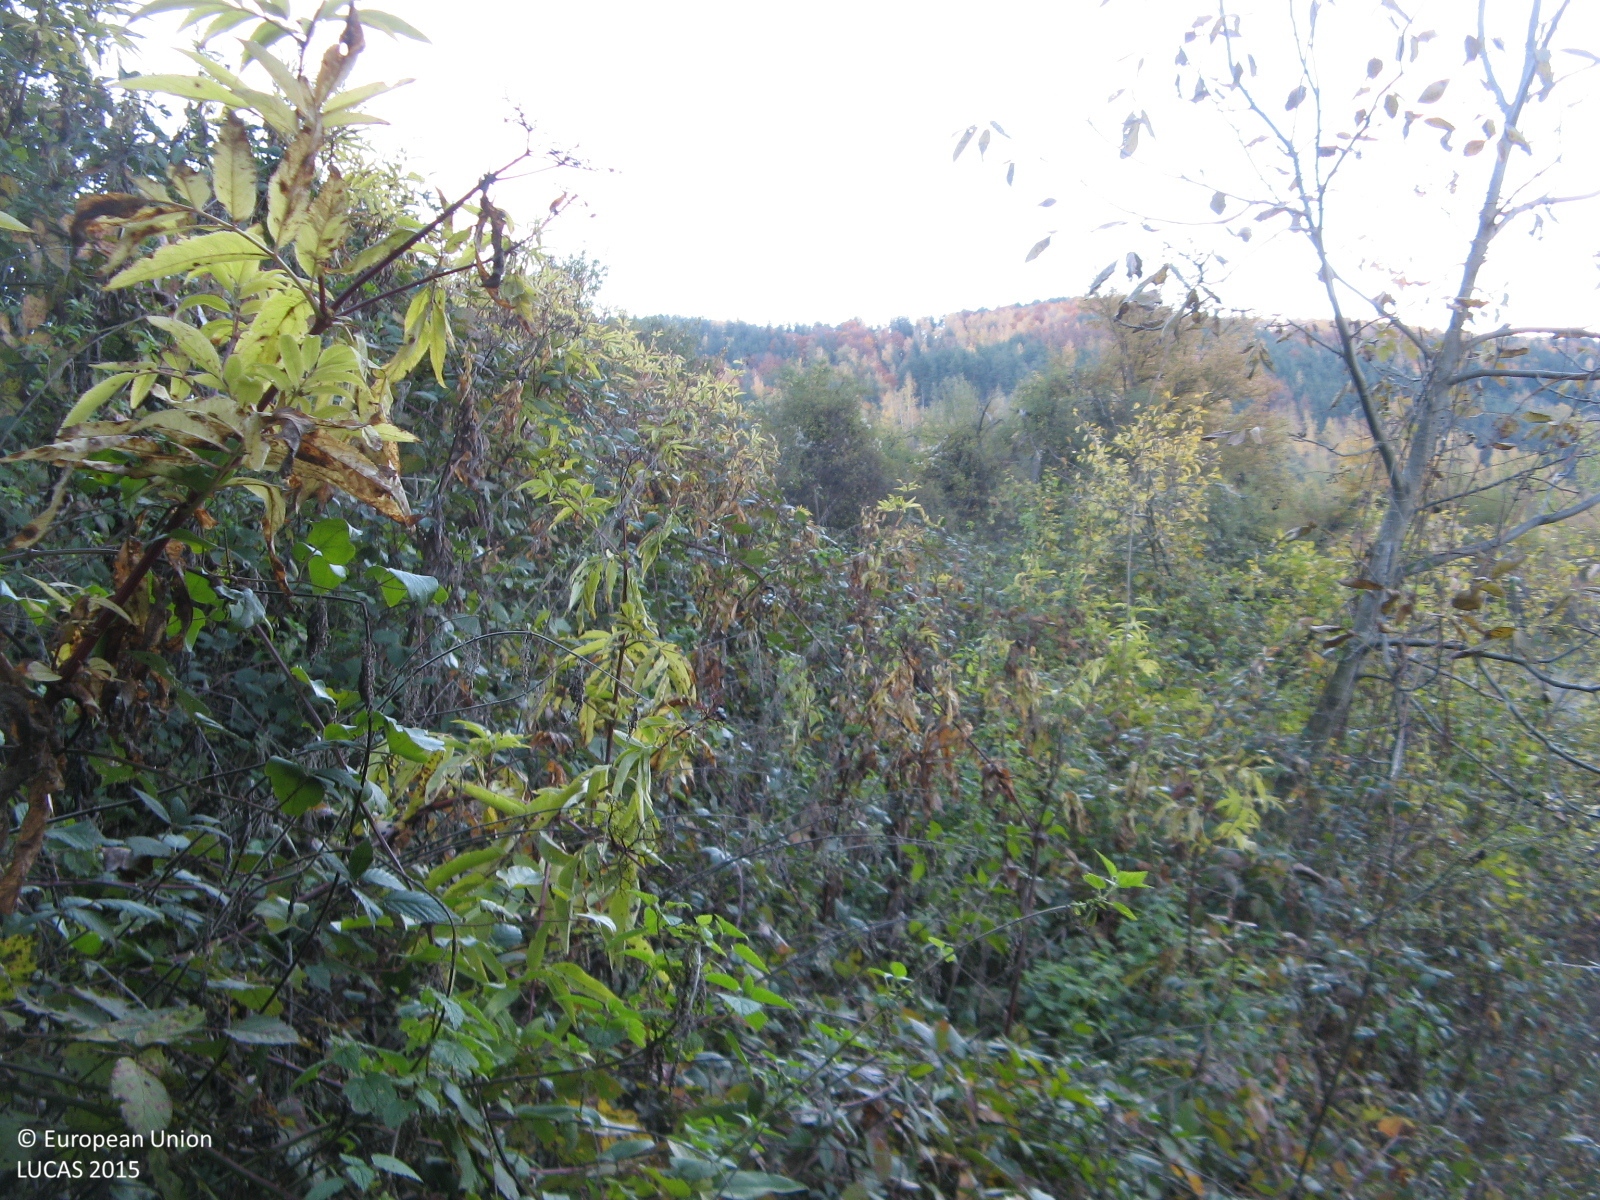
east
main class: Shrubland
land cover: Shrubland with sparse tree cover
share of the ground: > 75 %
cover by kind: shrubs 95 %, broadleaved forest trees 5 %
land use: Agriculture (excluding fallow land and kitchen gardens)
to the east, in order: Shrubland with sparse tree cover; Grassland without tree/shrub cover; Broadleaved woodland; Artificial constructions in urban areas; Grassland with sparse tree/shrub cover; Tracks; Grassland without tree/shrub cover; Broadleaved woodland; Tracks; Broadleaved woodland
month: November
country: BG
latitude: 41.5974
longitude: 25.1570
